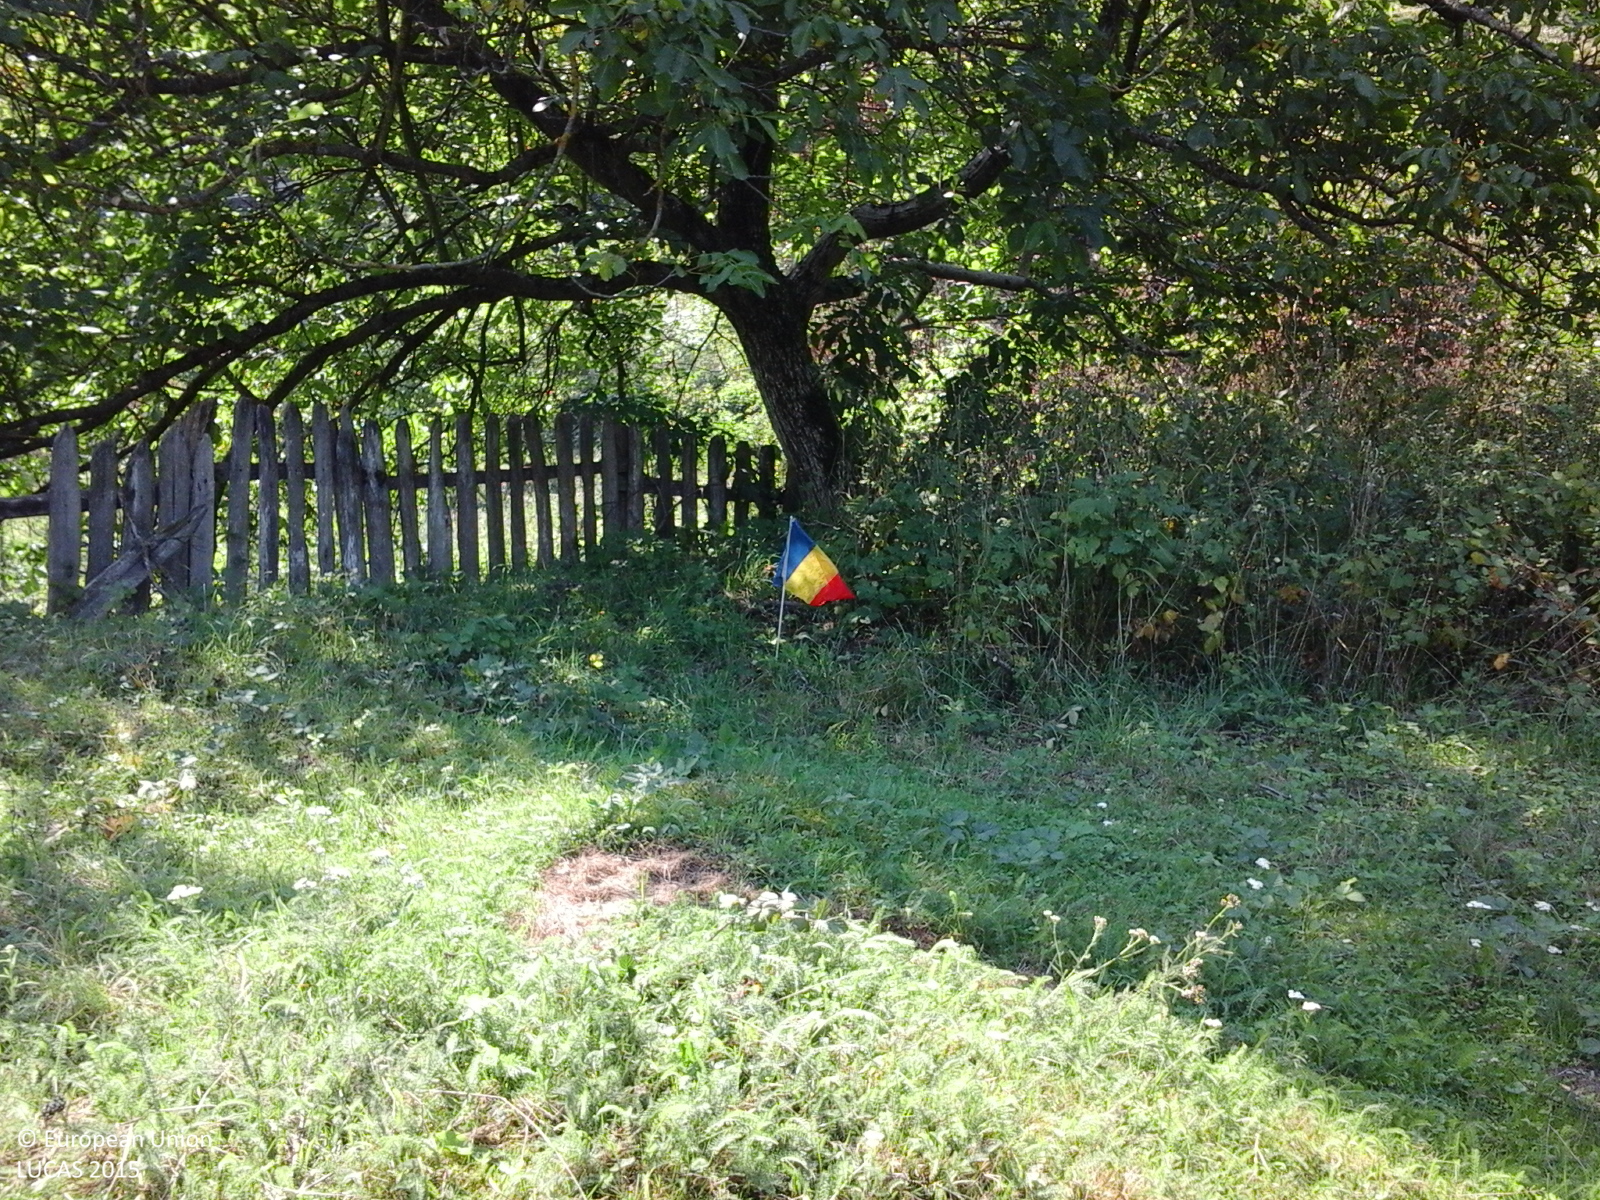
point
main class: Grassland
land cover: Grassland with sparse tree/shrub cover
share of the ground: > 75 %
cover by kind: herbaceous plants 85 %, shrubs 10 %, broadleaved forest trees 5 %
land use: Fallow land
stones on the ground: 10 - 25 %
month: August
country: RO
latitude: 46.2448
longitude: 22.0930
